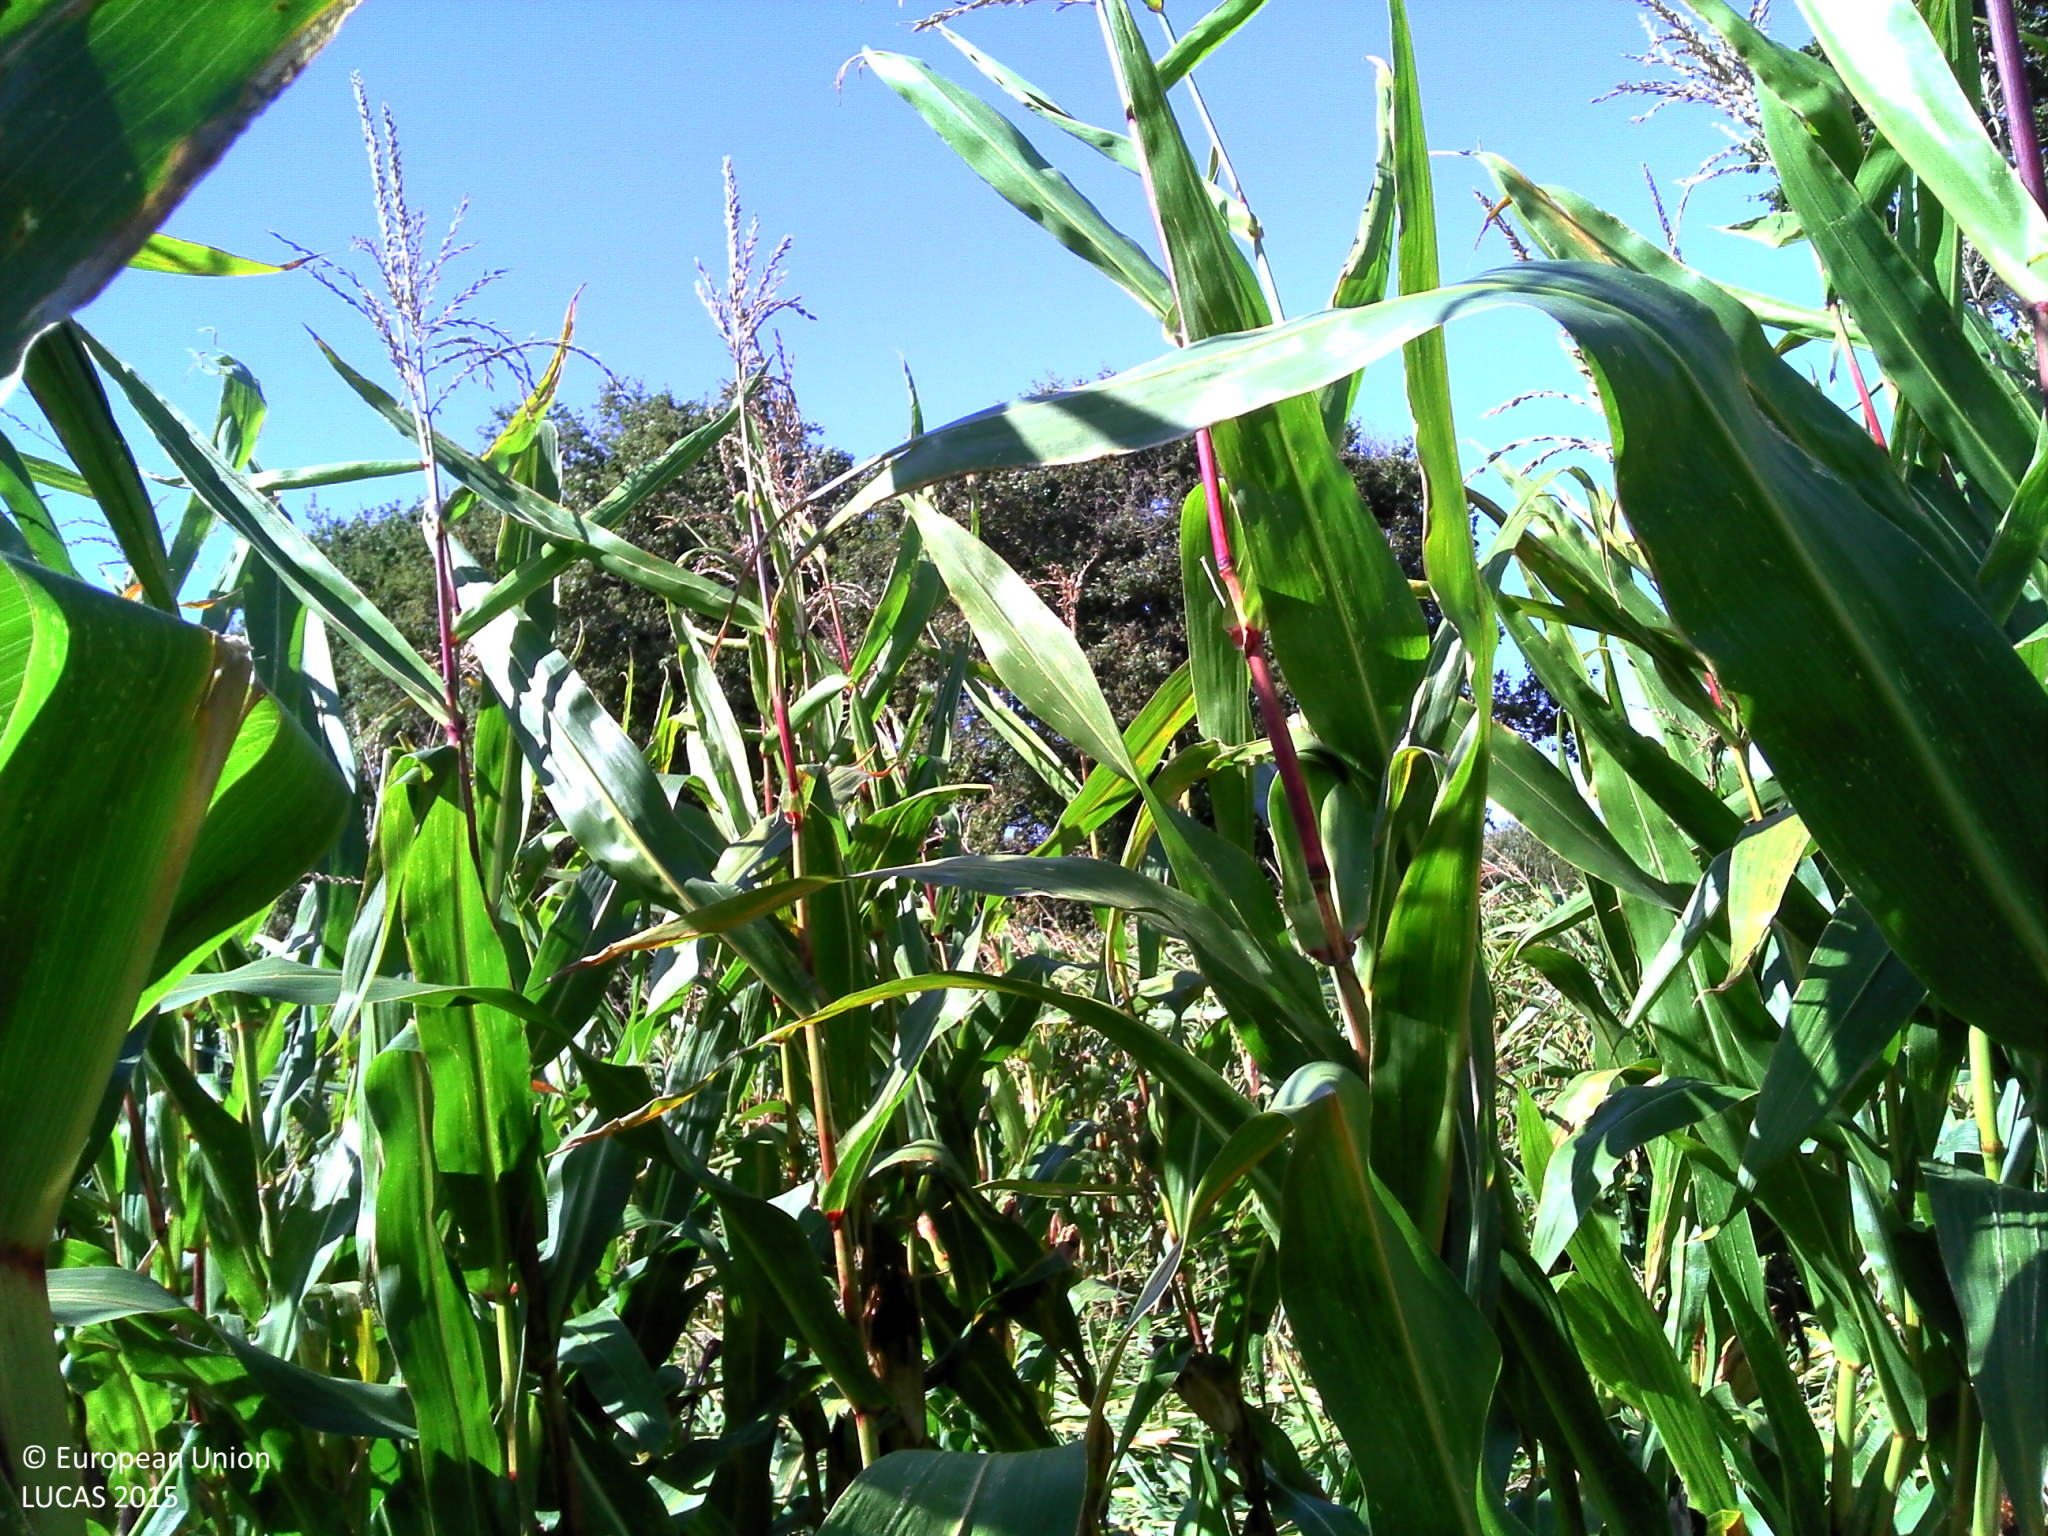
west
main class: Cropland
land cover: Maize
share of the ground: > 75 %
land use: Agriculture (excluding fallow land and kitchen gardens)
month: September
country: FR
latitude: 46.5839
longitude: -1.3246
